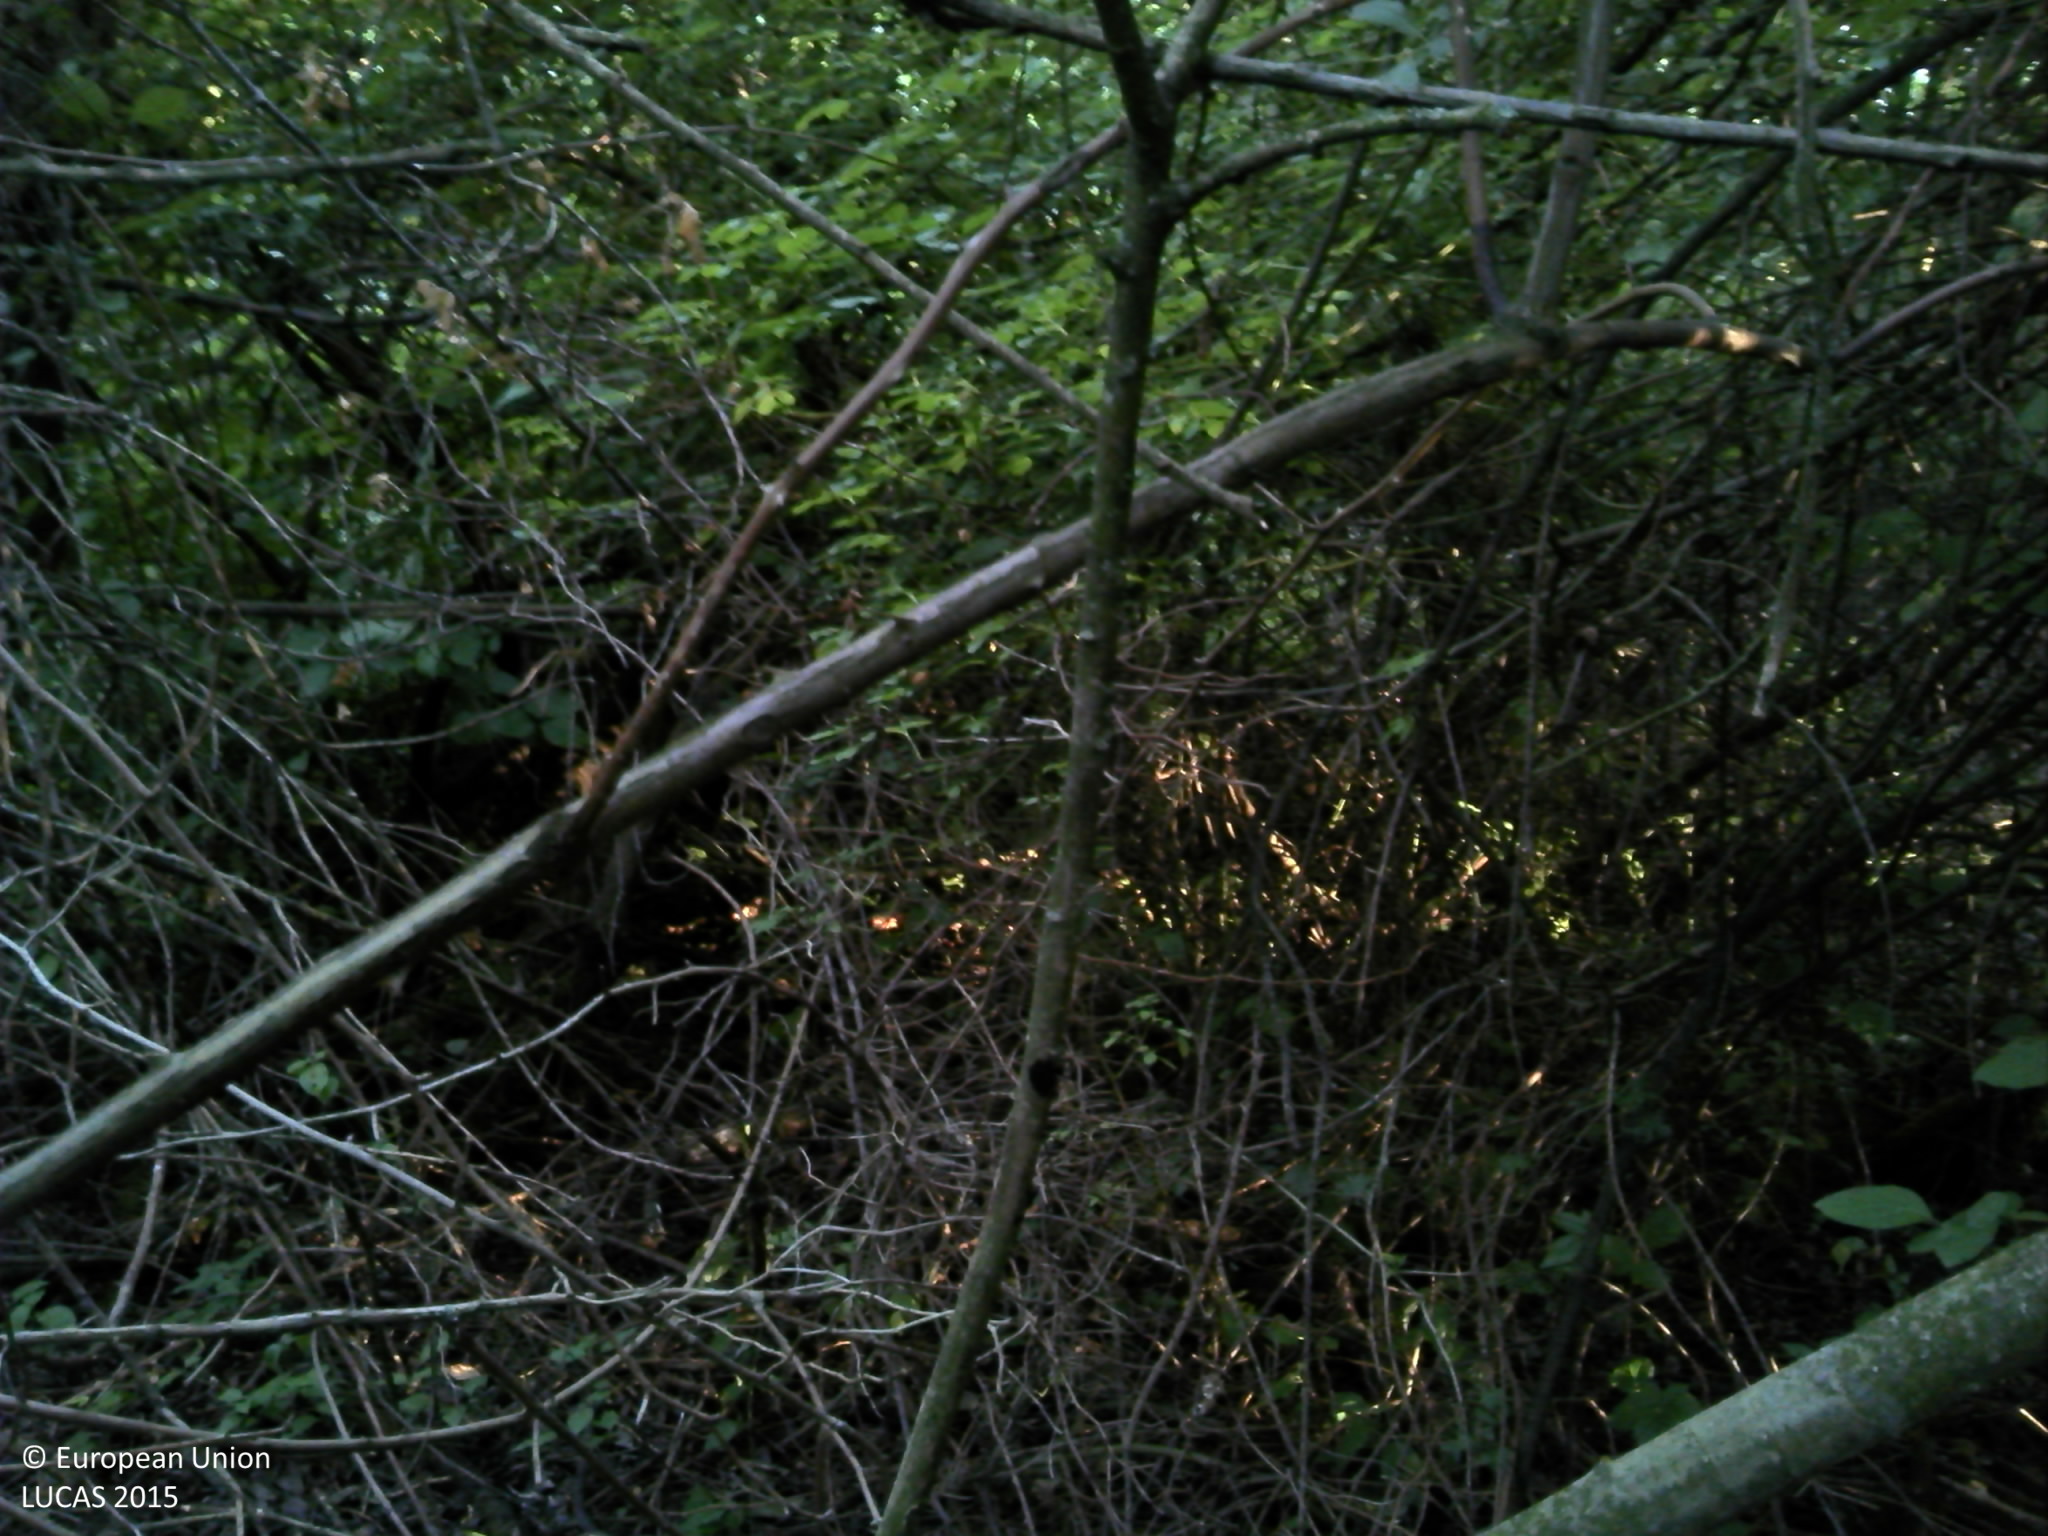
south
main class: Woodland
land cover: Broadleaved woodland
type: mesophytic deciduous forest
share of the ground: > 75 %
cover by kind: broadleaved forest trees 100 %
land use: Semi-natural and natural areas not in use
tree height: > 5 m
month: June
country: HR
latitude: 45.4364
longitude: 18.4556
